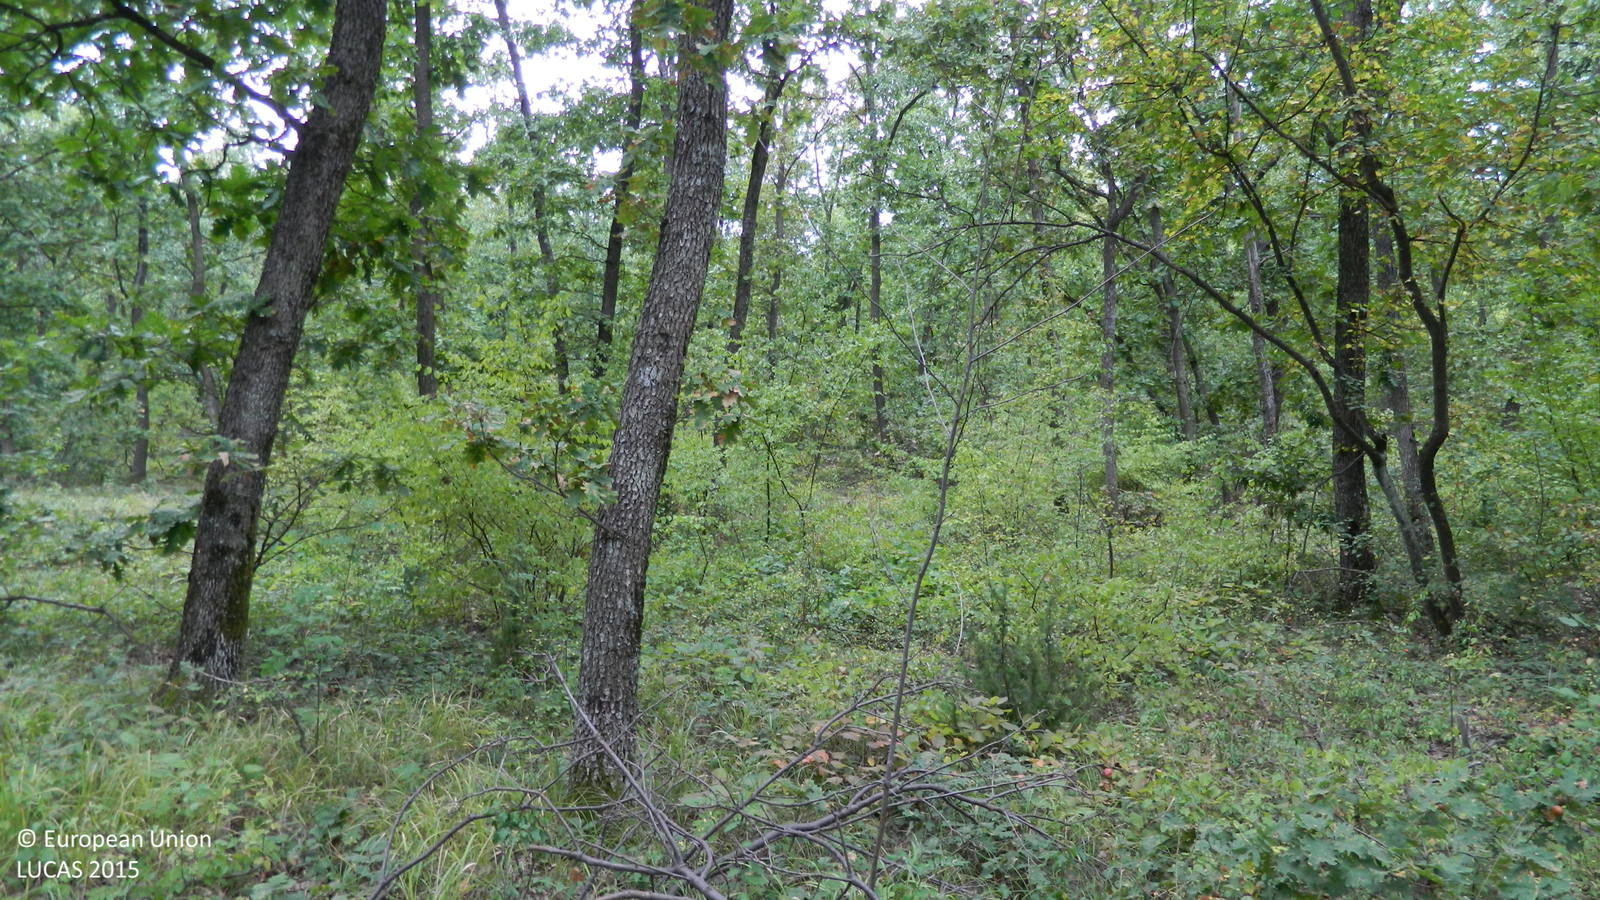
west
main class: Woodland
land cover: Broadleaved woodland
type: mesophytic deciduous forest
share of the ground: > 75 %
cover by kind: broadleaved forest trees 85 %, herbaceous plants 10 %, shrubs 5 %
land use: Forestry
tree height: > 5 m
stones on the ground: < 10 %
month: September
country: BG
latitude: 41.7358
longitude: 25.6824
